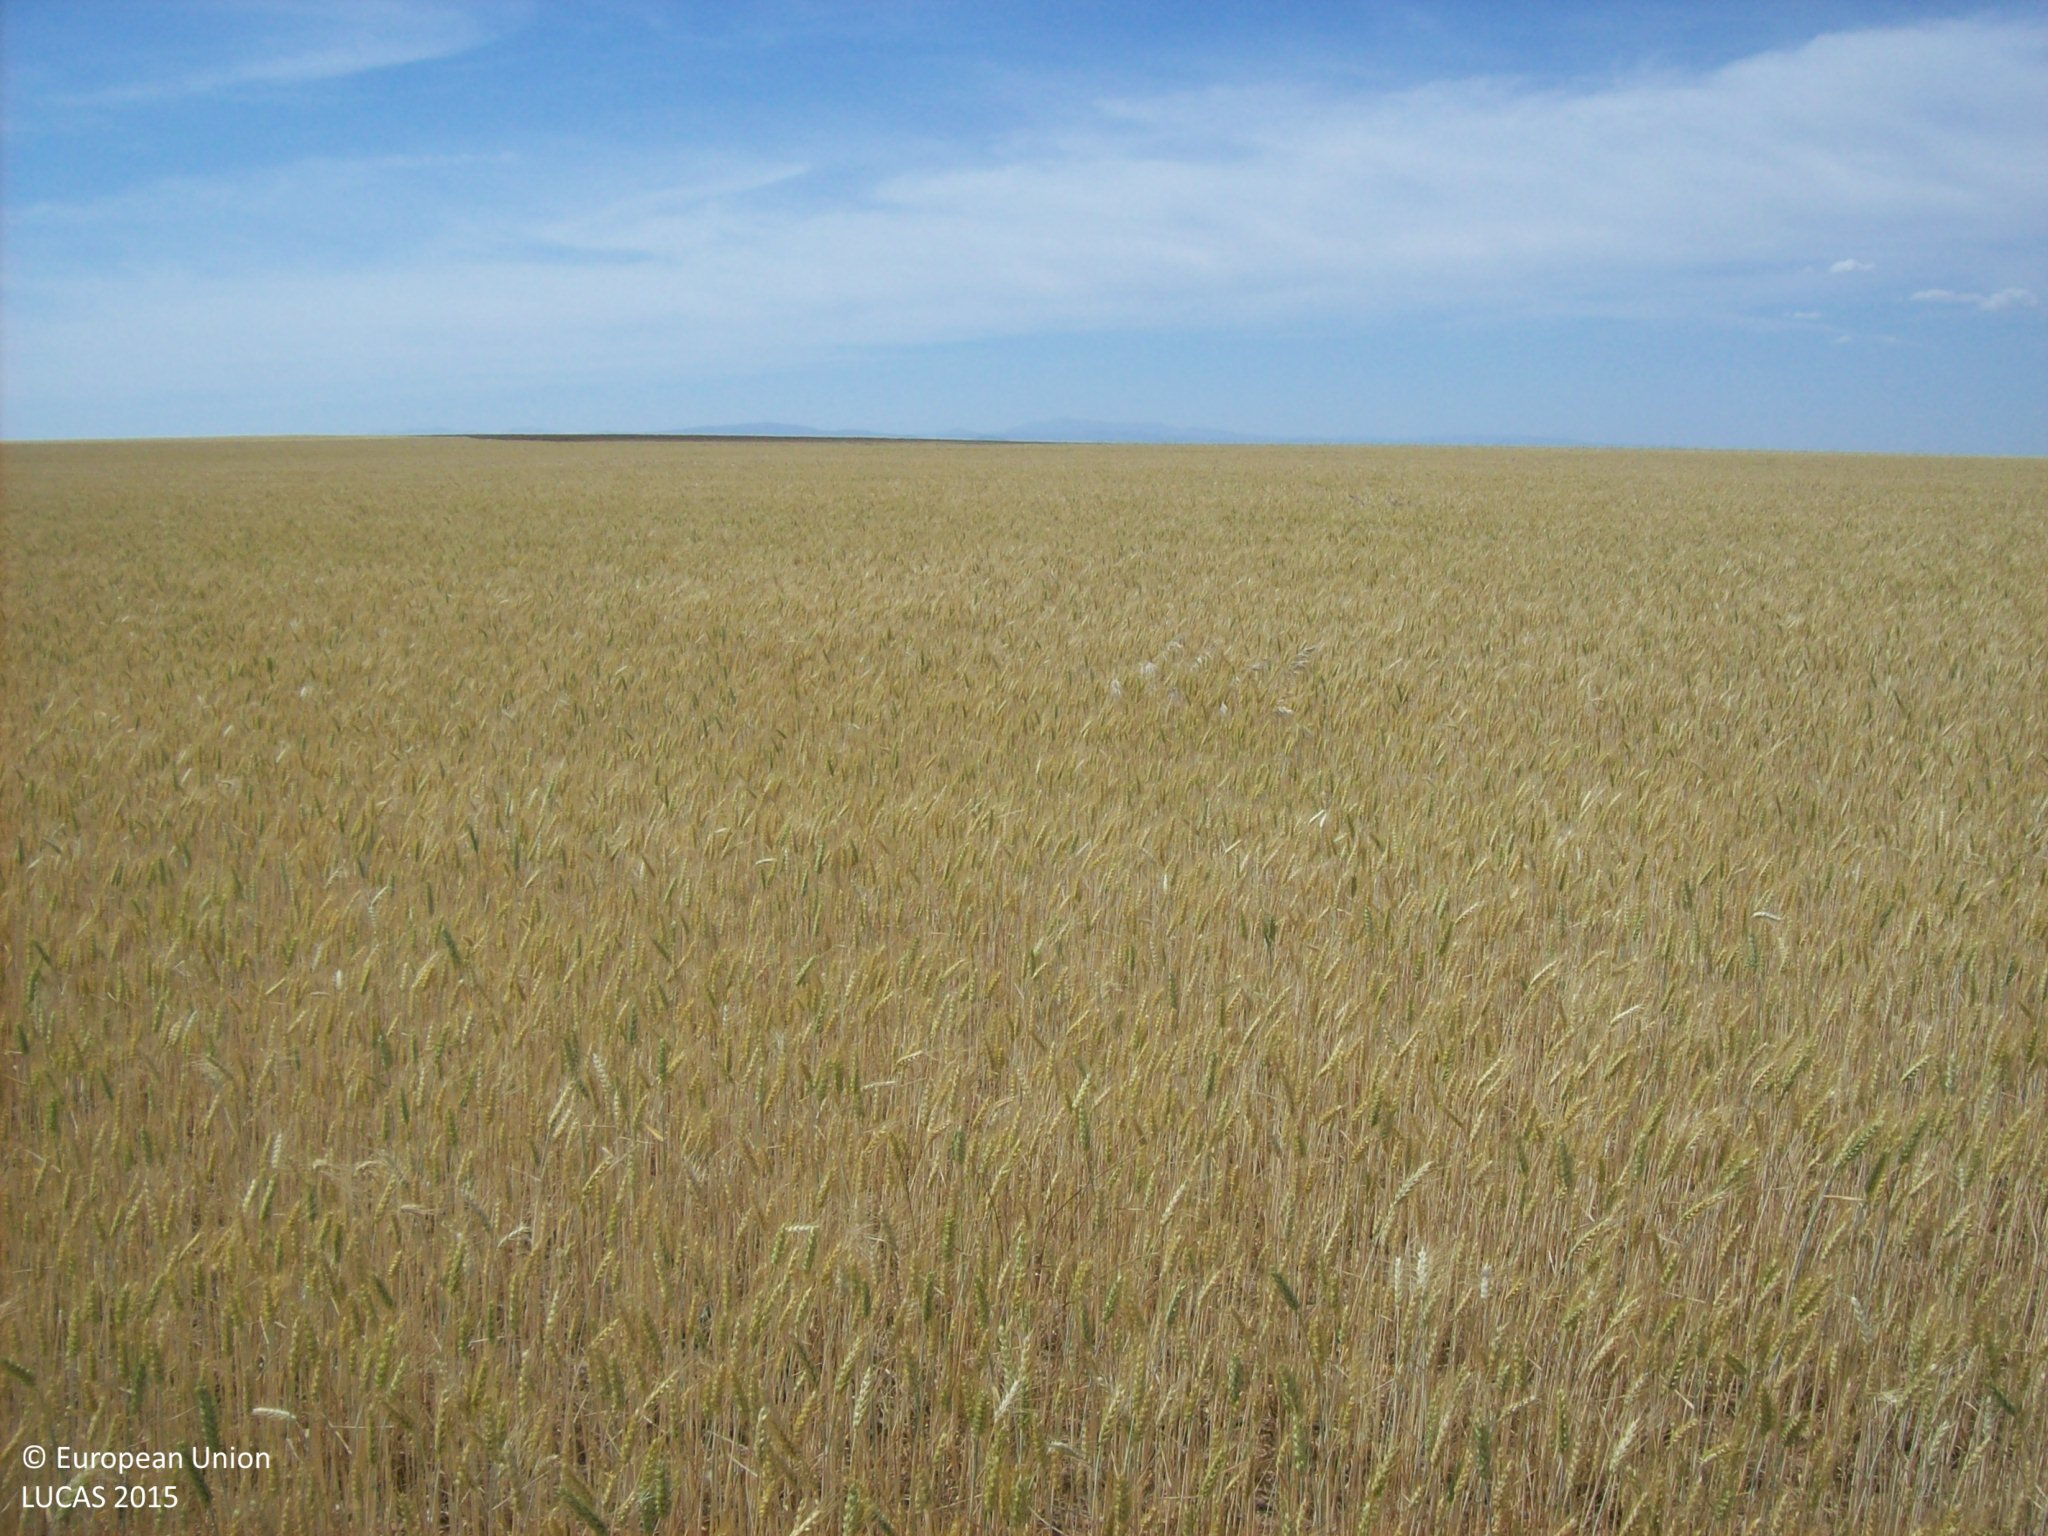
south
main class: Cropland
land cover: Common wheat
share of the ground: > 75 %
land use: Agriculture (excluding fallow land and kitchen gardens)
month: June
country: ES
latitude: 41.0531
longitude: -4.9981
